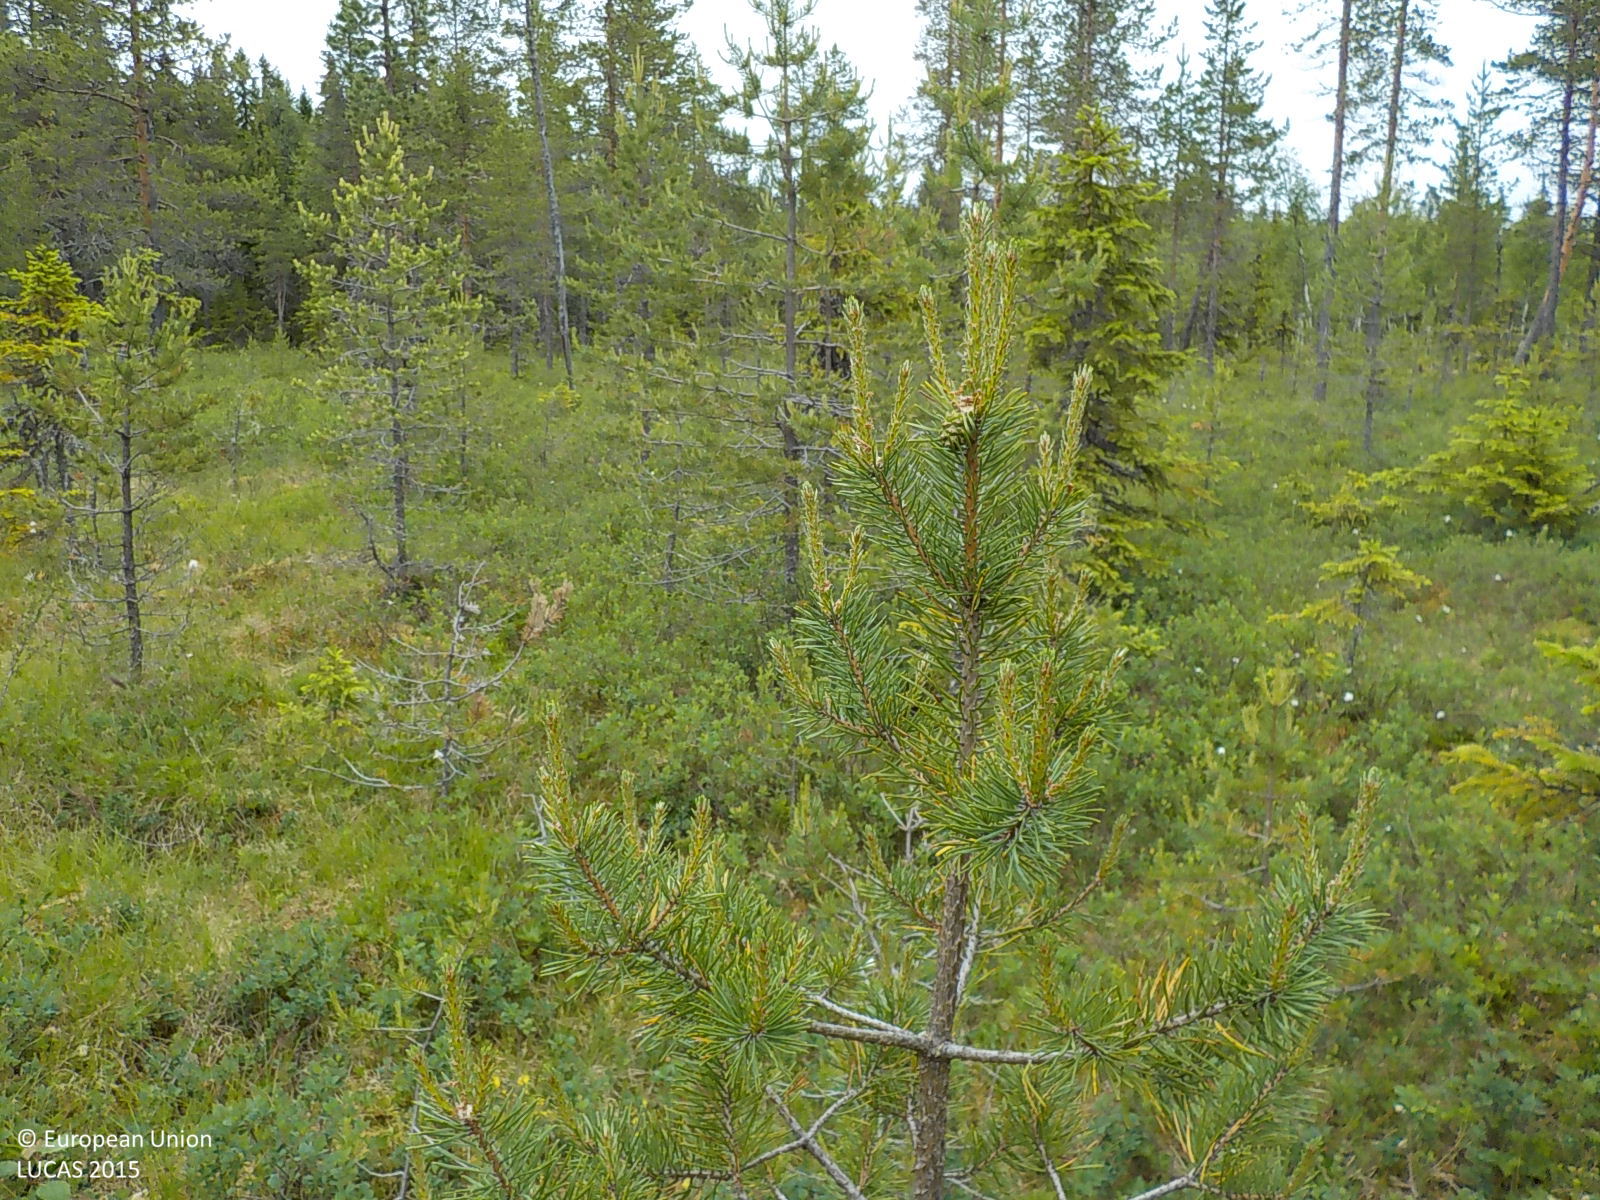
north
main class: Woodland
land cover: Spruce dominated coniferous woodland
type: boreal forest
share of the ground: 50 - 75 %
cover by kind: coniferous forest trees 50 %, shrubs 25 %, herbaceous plants 20 %, broadleaved forest trees 5 %
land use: Semi-natural and natural areas not in use
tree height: < 5 m
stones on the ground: < 10 %
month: July
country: SE
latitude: 63.1725
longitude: 16.6290
